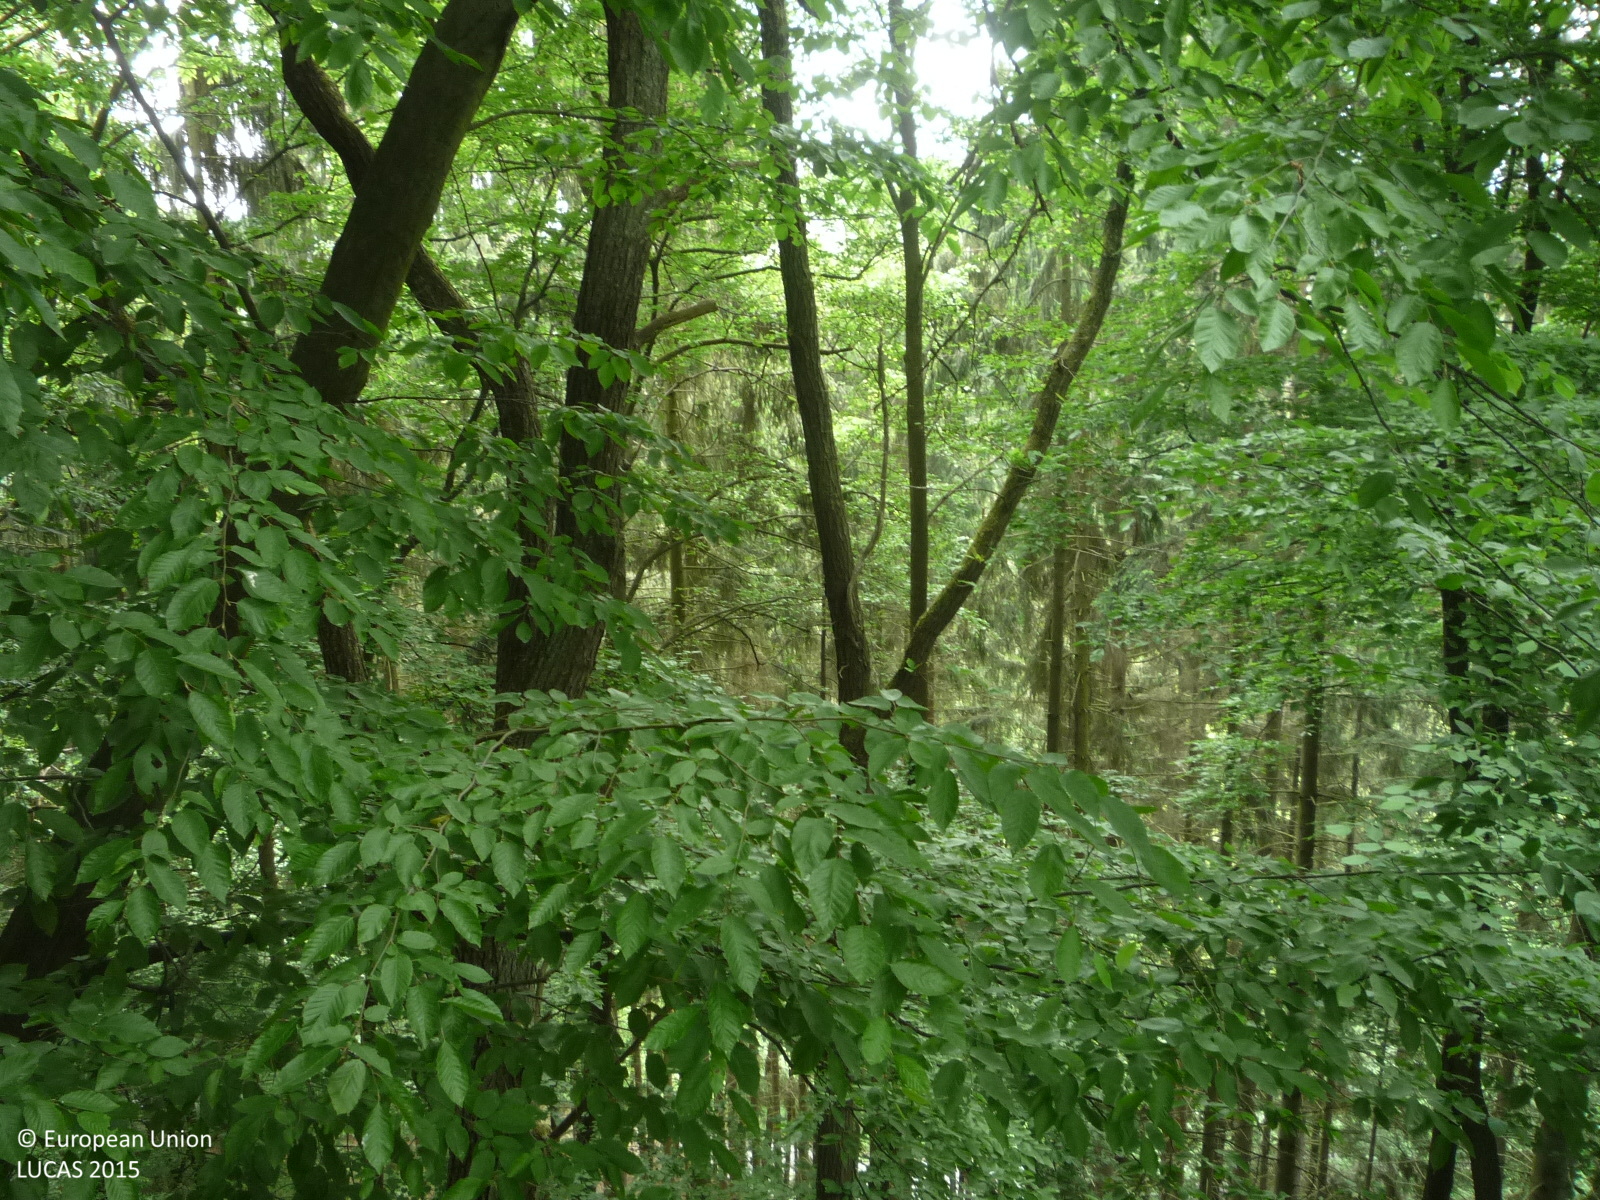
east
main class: Woodland
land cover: Broadleaved woodland
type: mesophytic deciduous forest
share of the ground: > 75 %
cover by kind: broadleaved forest trees 90 %, herbaceous plants 10 %
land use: Semi-natural and natural areas not in use
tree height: > 5 m
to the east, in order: Broadleaved woodland; Rocks and stones; Spruce dominated coniferous woodland; Spruce dominated mixed woodland; Rock outcrops; Paved roads, cycling and walking lanes; Broadleaved woodland; Rock outcrops; Shrubland without tree cover; Spontaneously vegetated surfaces; Temporary grasslands; Paved roads, cycling and walking lanes; Other mixed woodland; Rocks and stones; Pine dominated mixed woodland; Pine dominated coniferous woodland; Pine dominated mixed woodland
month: May
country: CZ
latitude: 50.4357
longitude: 14.5494
